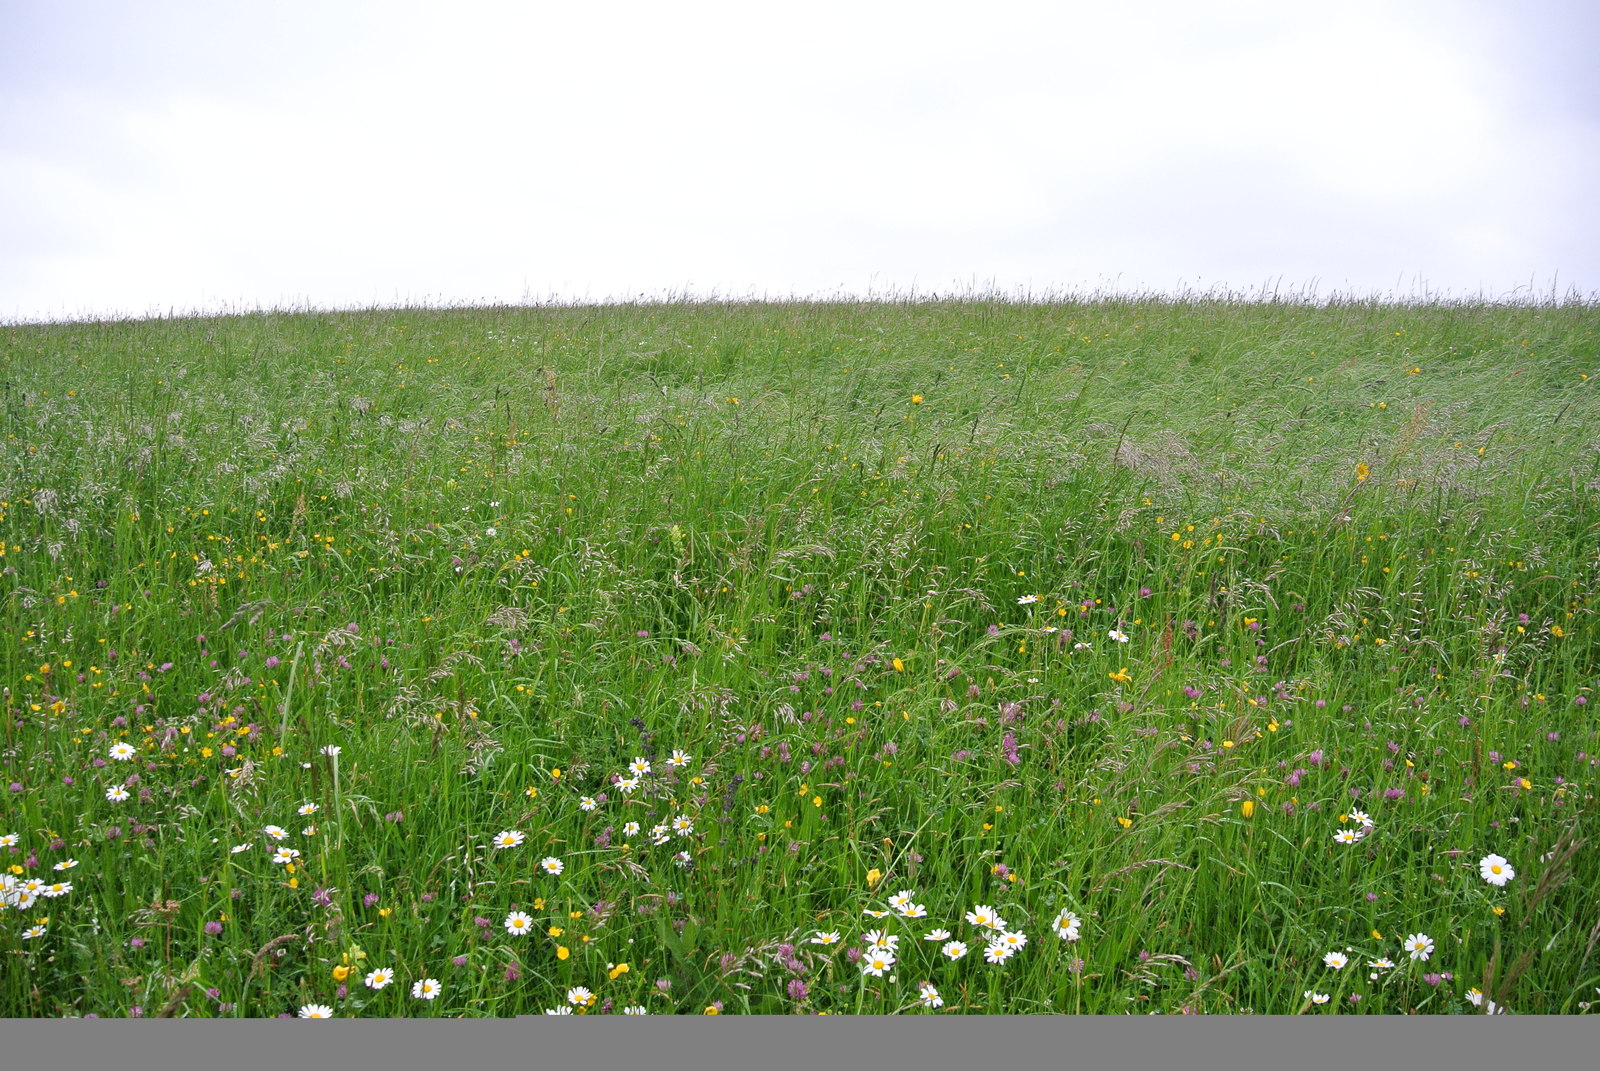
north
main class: Grassland
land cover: Grassland without tree/shrub cover
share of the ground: > 75 %
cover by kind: herbaceous plants 100 %
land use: Agriculture (excluding fallow land and kitchen gardens)
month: May
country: AT
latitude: 48.1074
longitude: 15.7914
